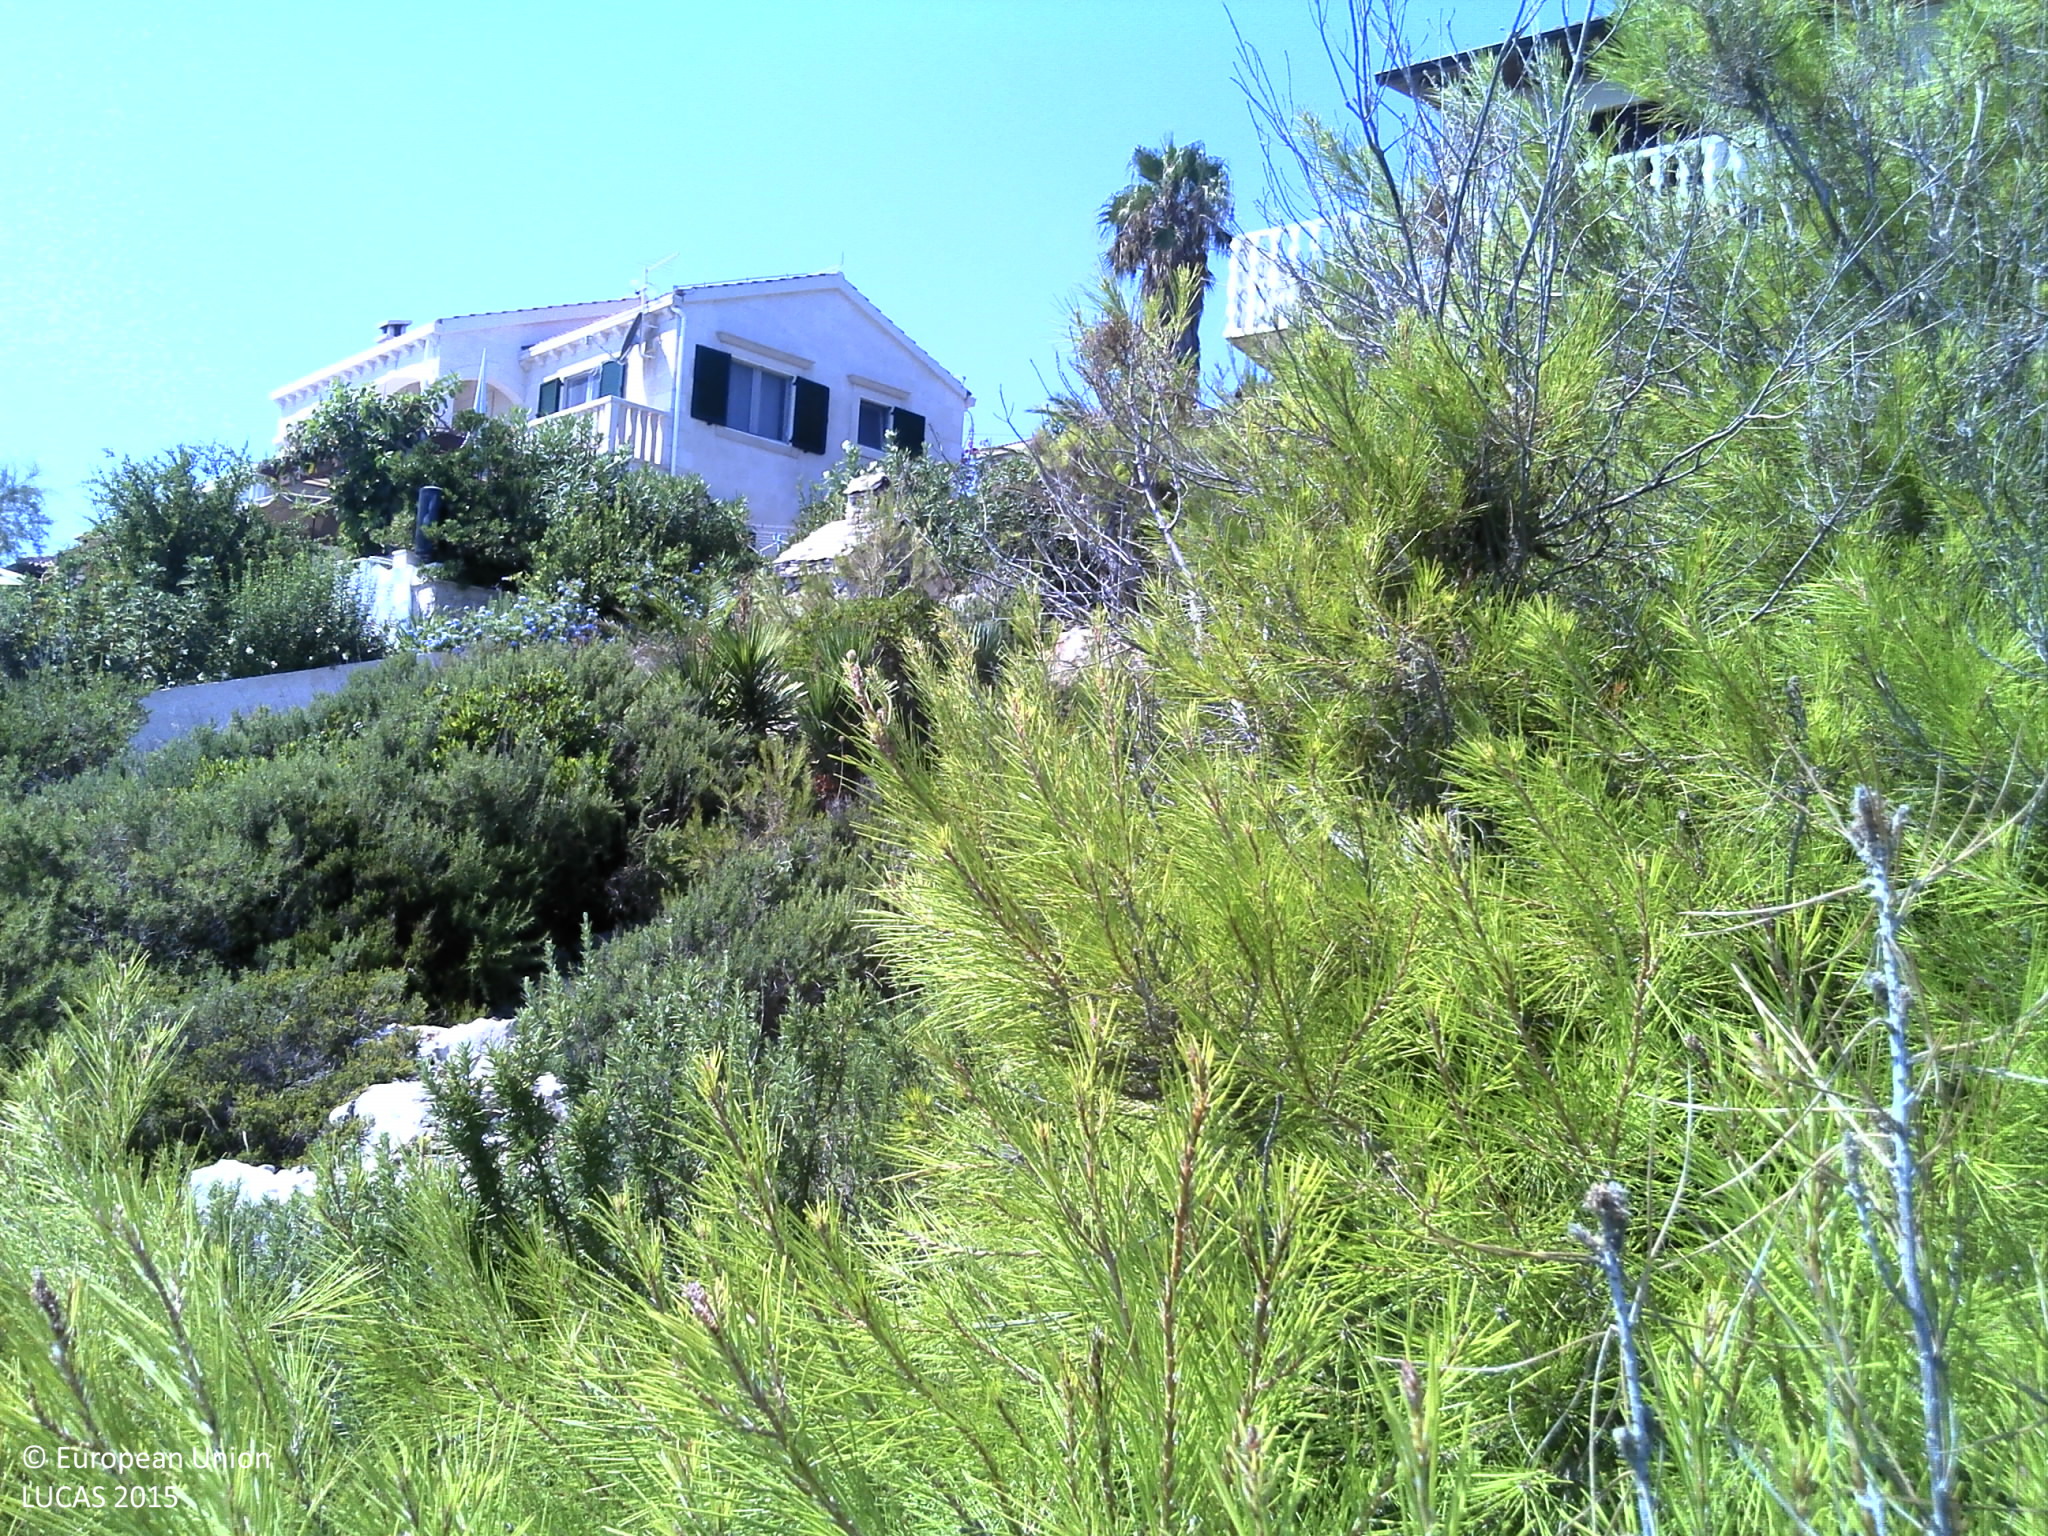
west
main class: Shrubland
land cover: Shrubland with sparse tree cover
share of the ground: > 75 %
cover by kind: shrubs 70 %, unconsolidated bare surface 15 %, coniferous forest trees 5 %, herbaceous plants 5 %, consolidated bare surface 5 %
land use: Semi-natural and natural areas not in use
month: August
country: HR
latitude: 43.0411
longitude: 16.2365
